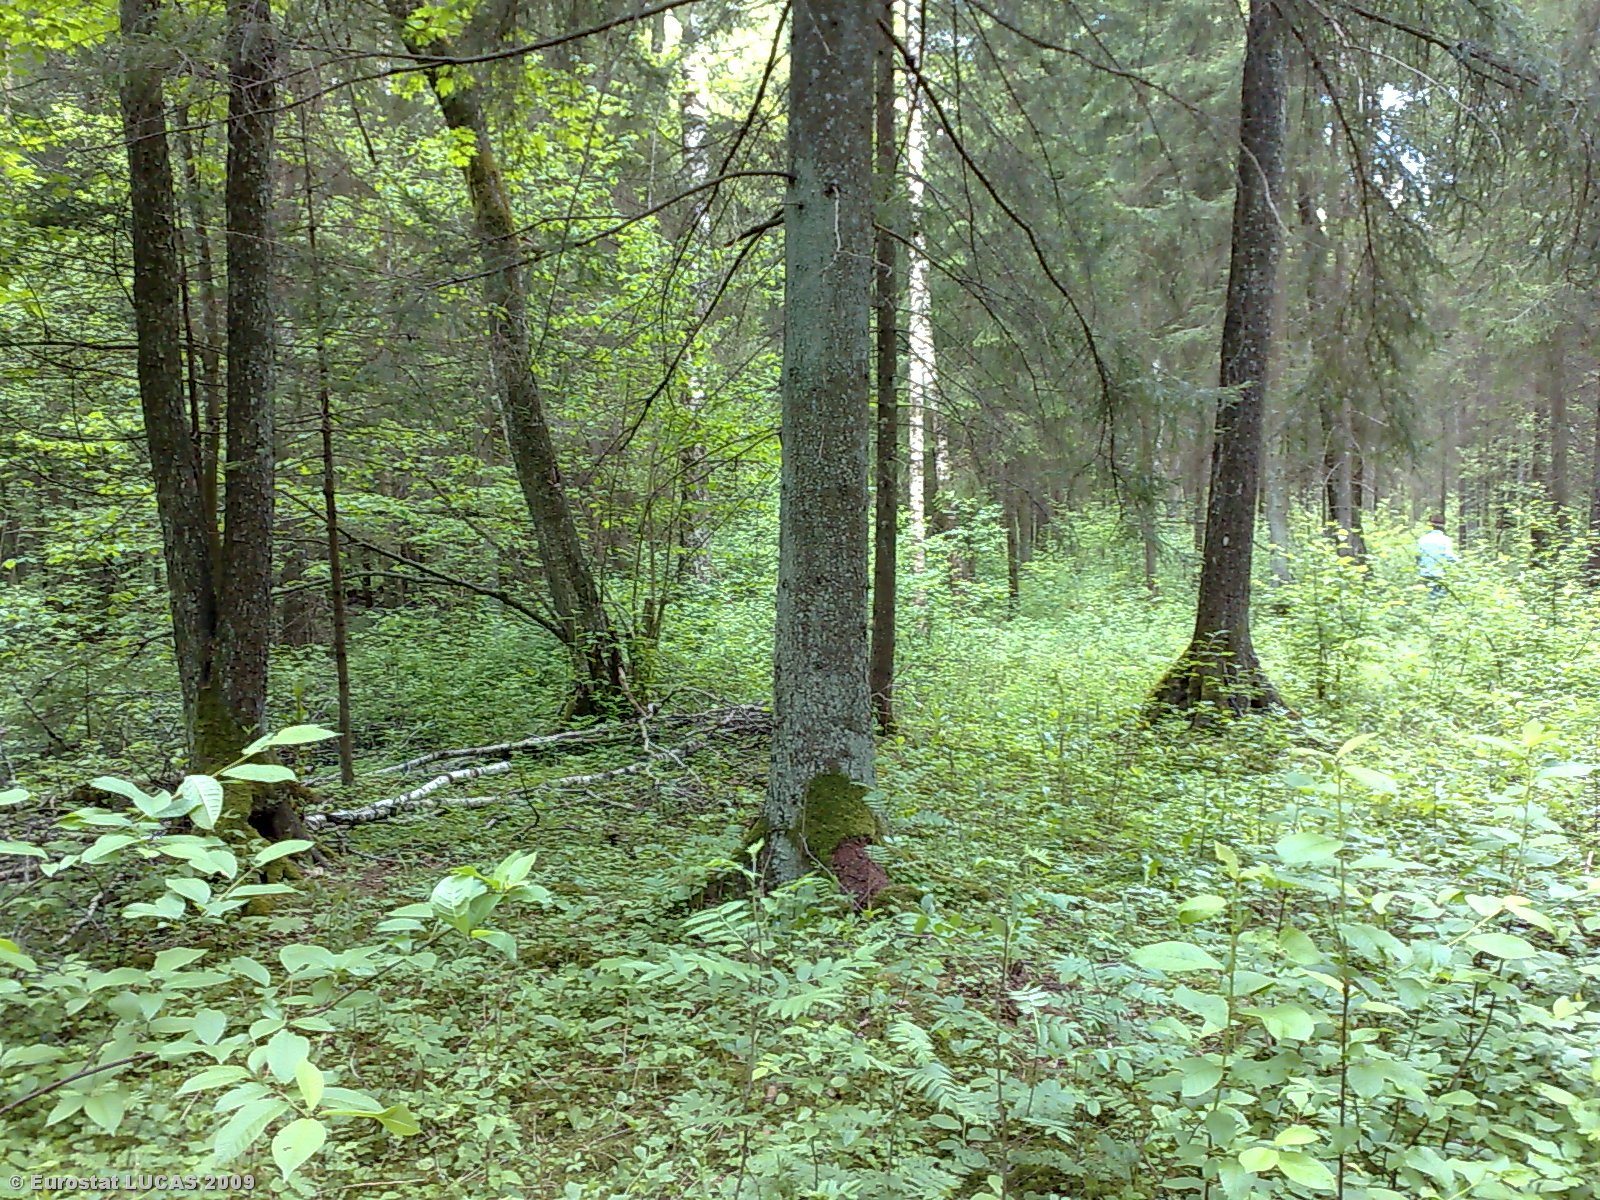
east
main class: Woodland
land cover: Mixed woodland
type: hemiboreal forest and nemoral coniferous forest and mixed broadleaved-coniferous forest
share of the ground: > 75 %
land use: Forestry
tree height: > 5 m
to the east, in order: Mixed woodland; Tracks; Mixed woodland
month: May
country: LT
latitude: 55.5968
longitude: 23.8446
